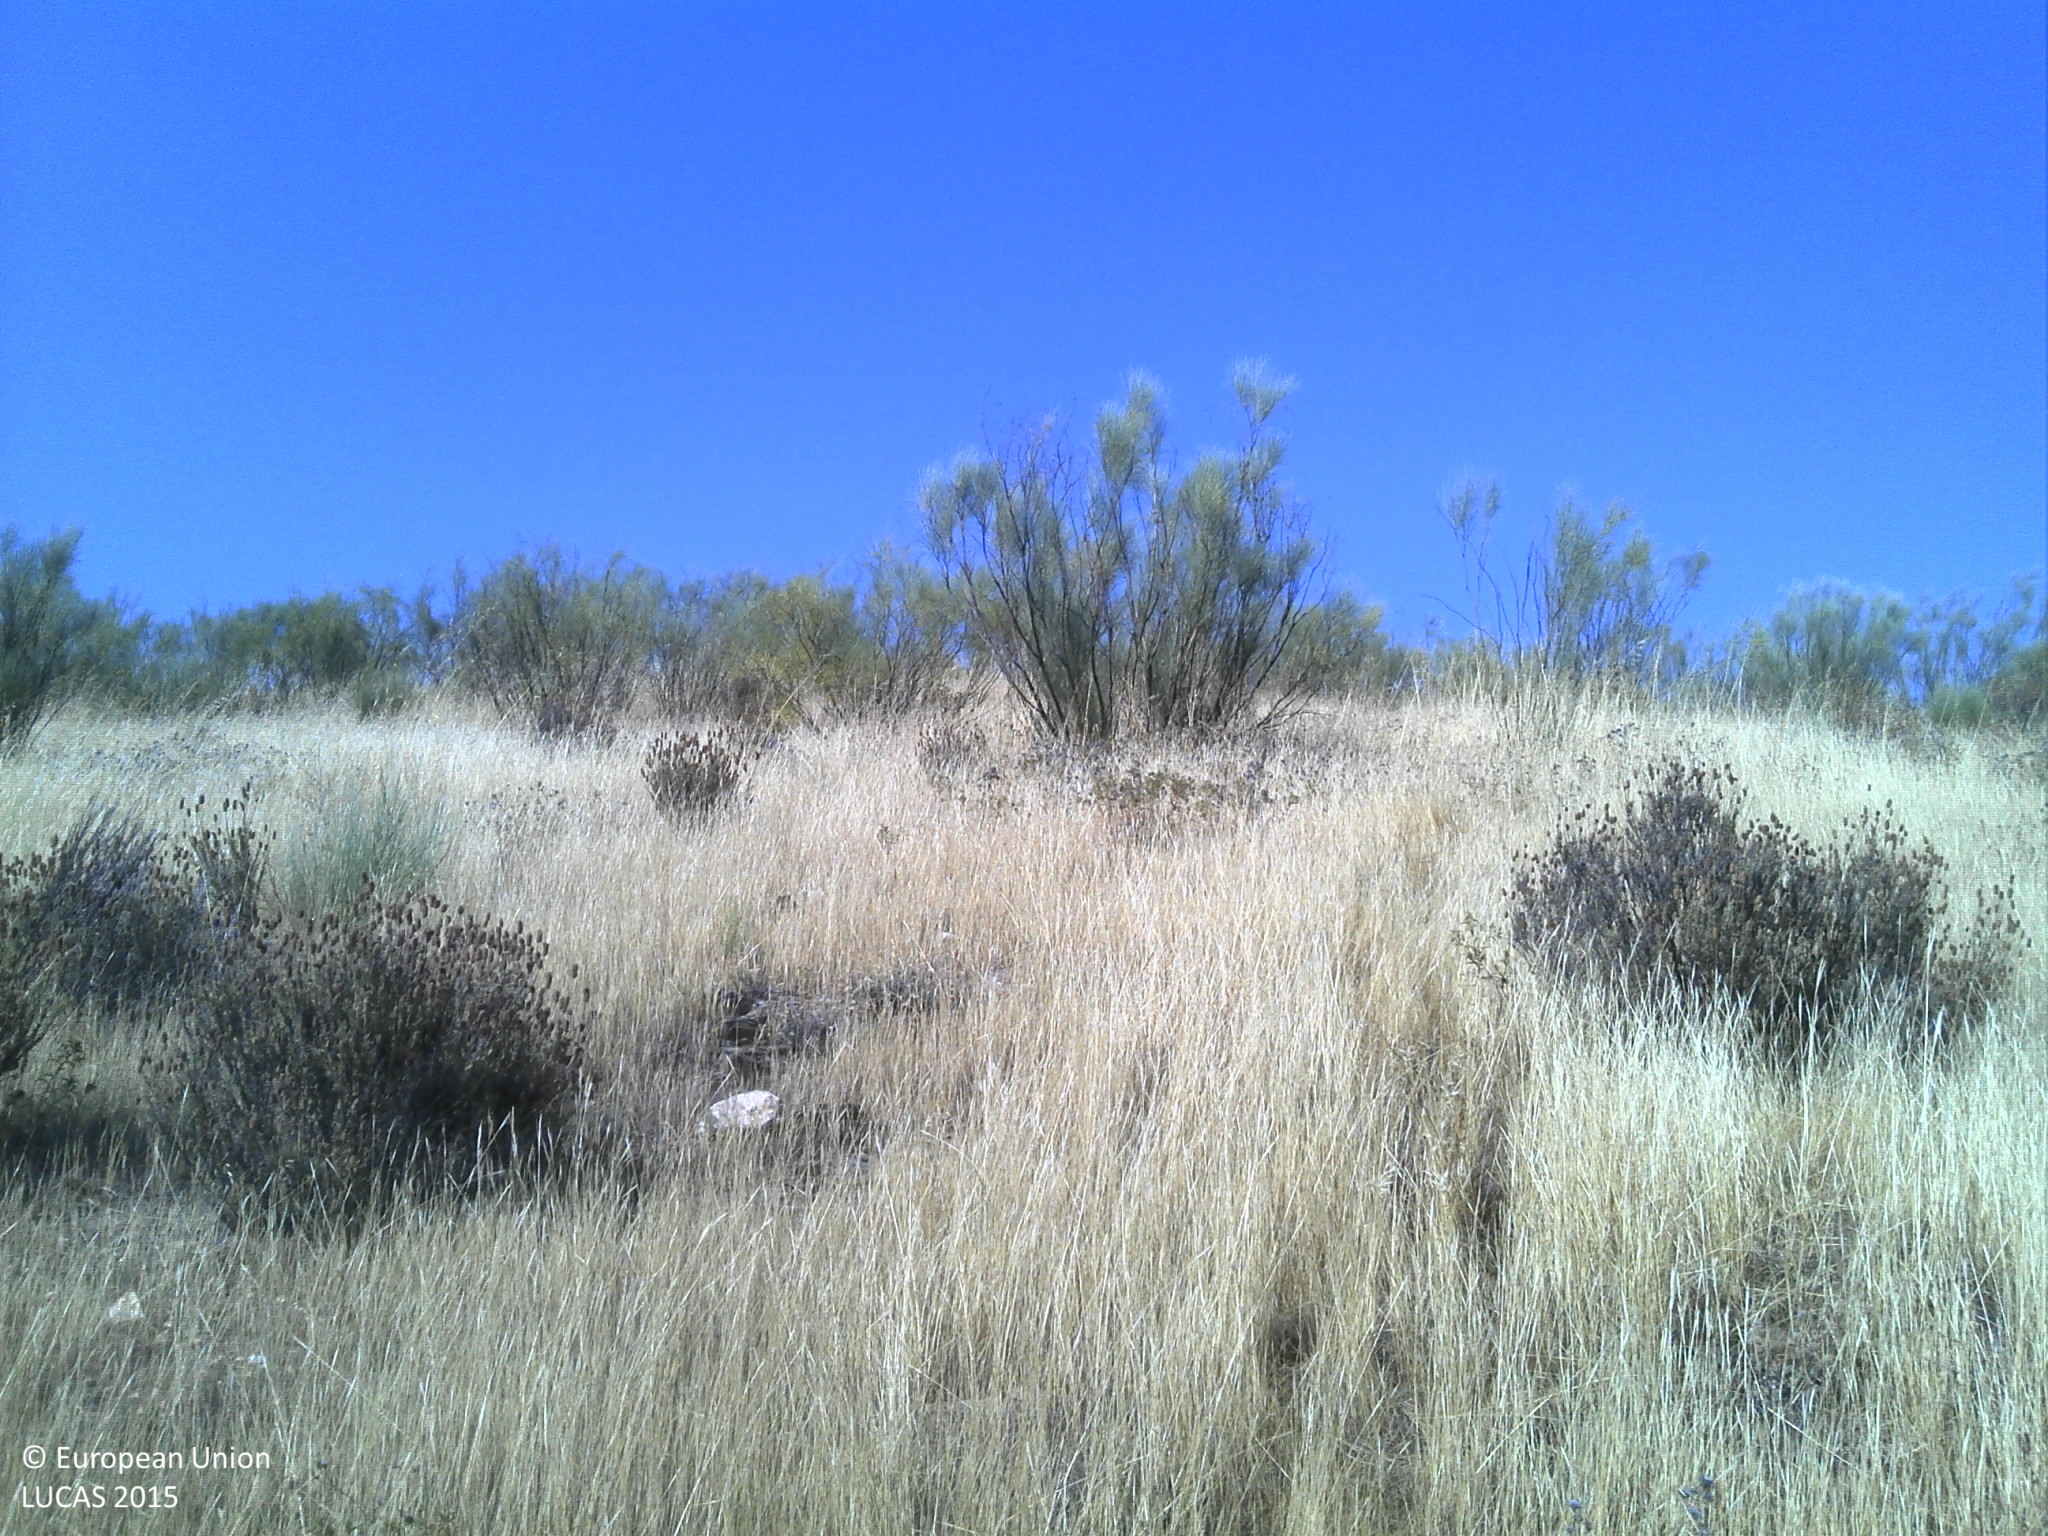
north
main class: Shrubland
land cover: Shrubland without tree cover
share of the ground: 50 - 75 %
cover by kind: shrubs 55 %, herbaceous plants 45 %
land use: Agriculture (excluding fallow land and kitchen gardens)
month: June
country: PT
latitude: 39.7385
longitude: -7.1612
